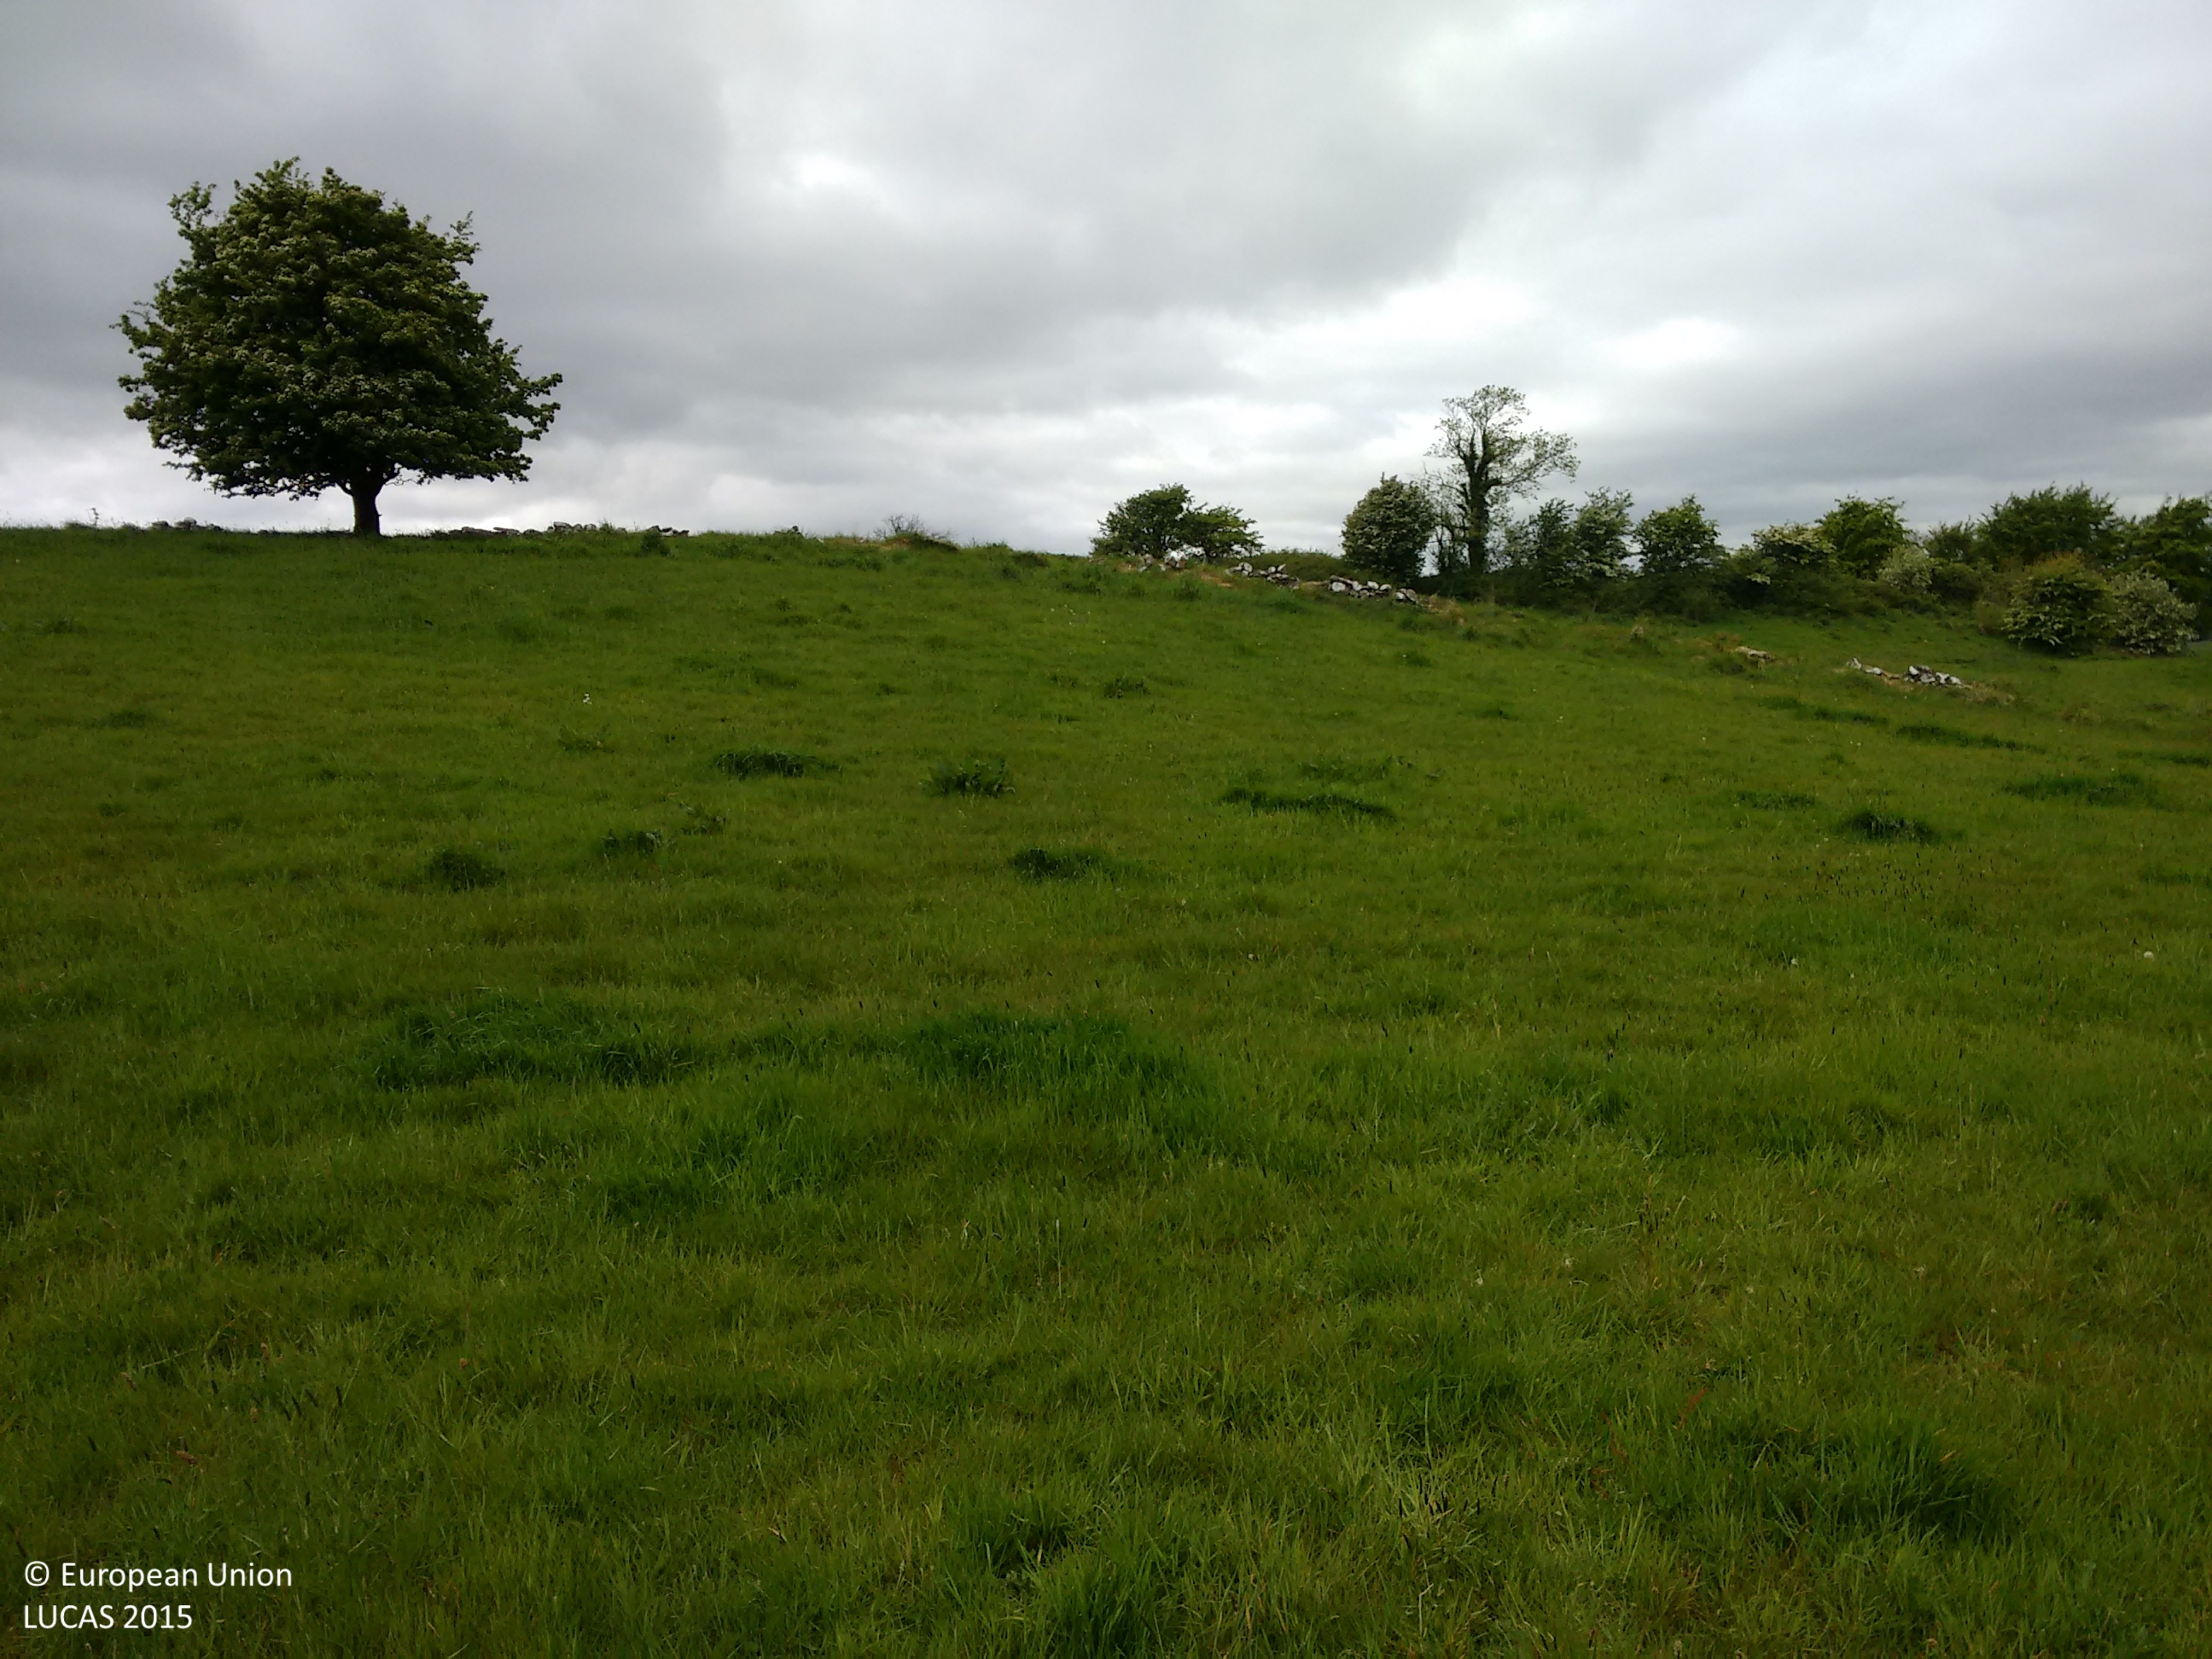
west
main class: Grassland
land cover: Grassland without tree/shrub cover
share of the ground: > 75 %
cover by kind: herbaceous plants 100 %
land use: Agriculture (excluding fallow land and kitchen gardens)
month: May
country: IE
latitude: 53.3468
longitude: -8.5982
